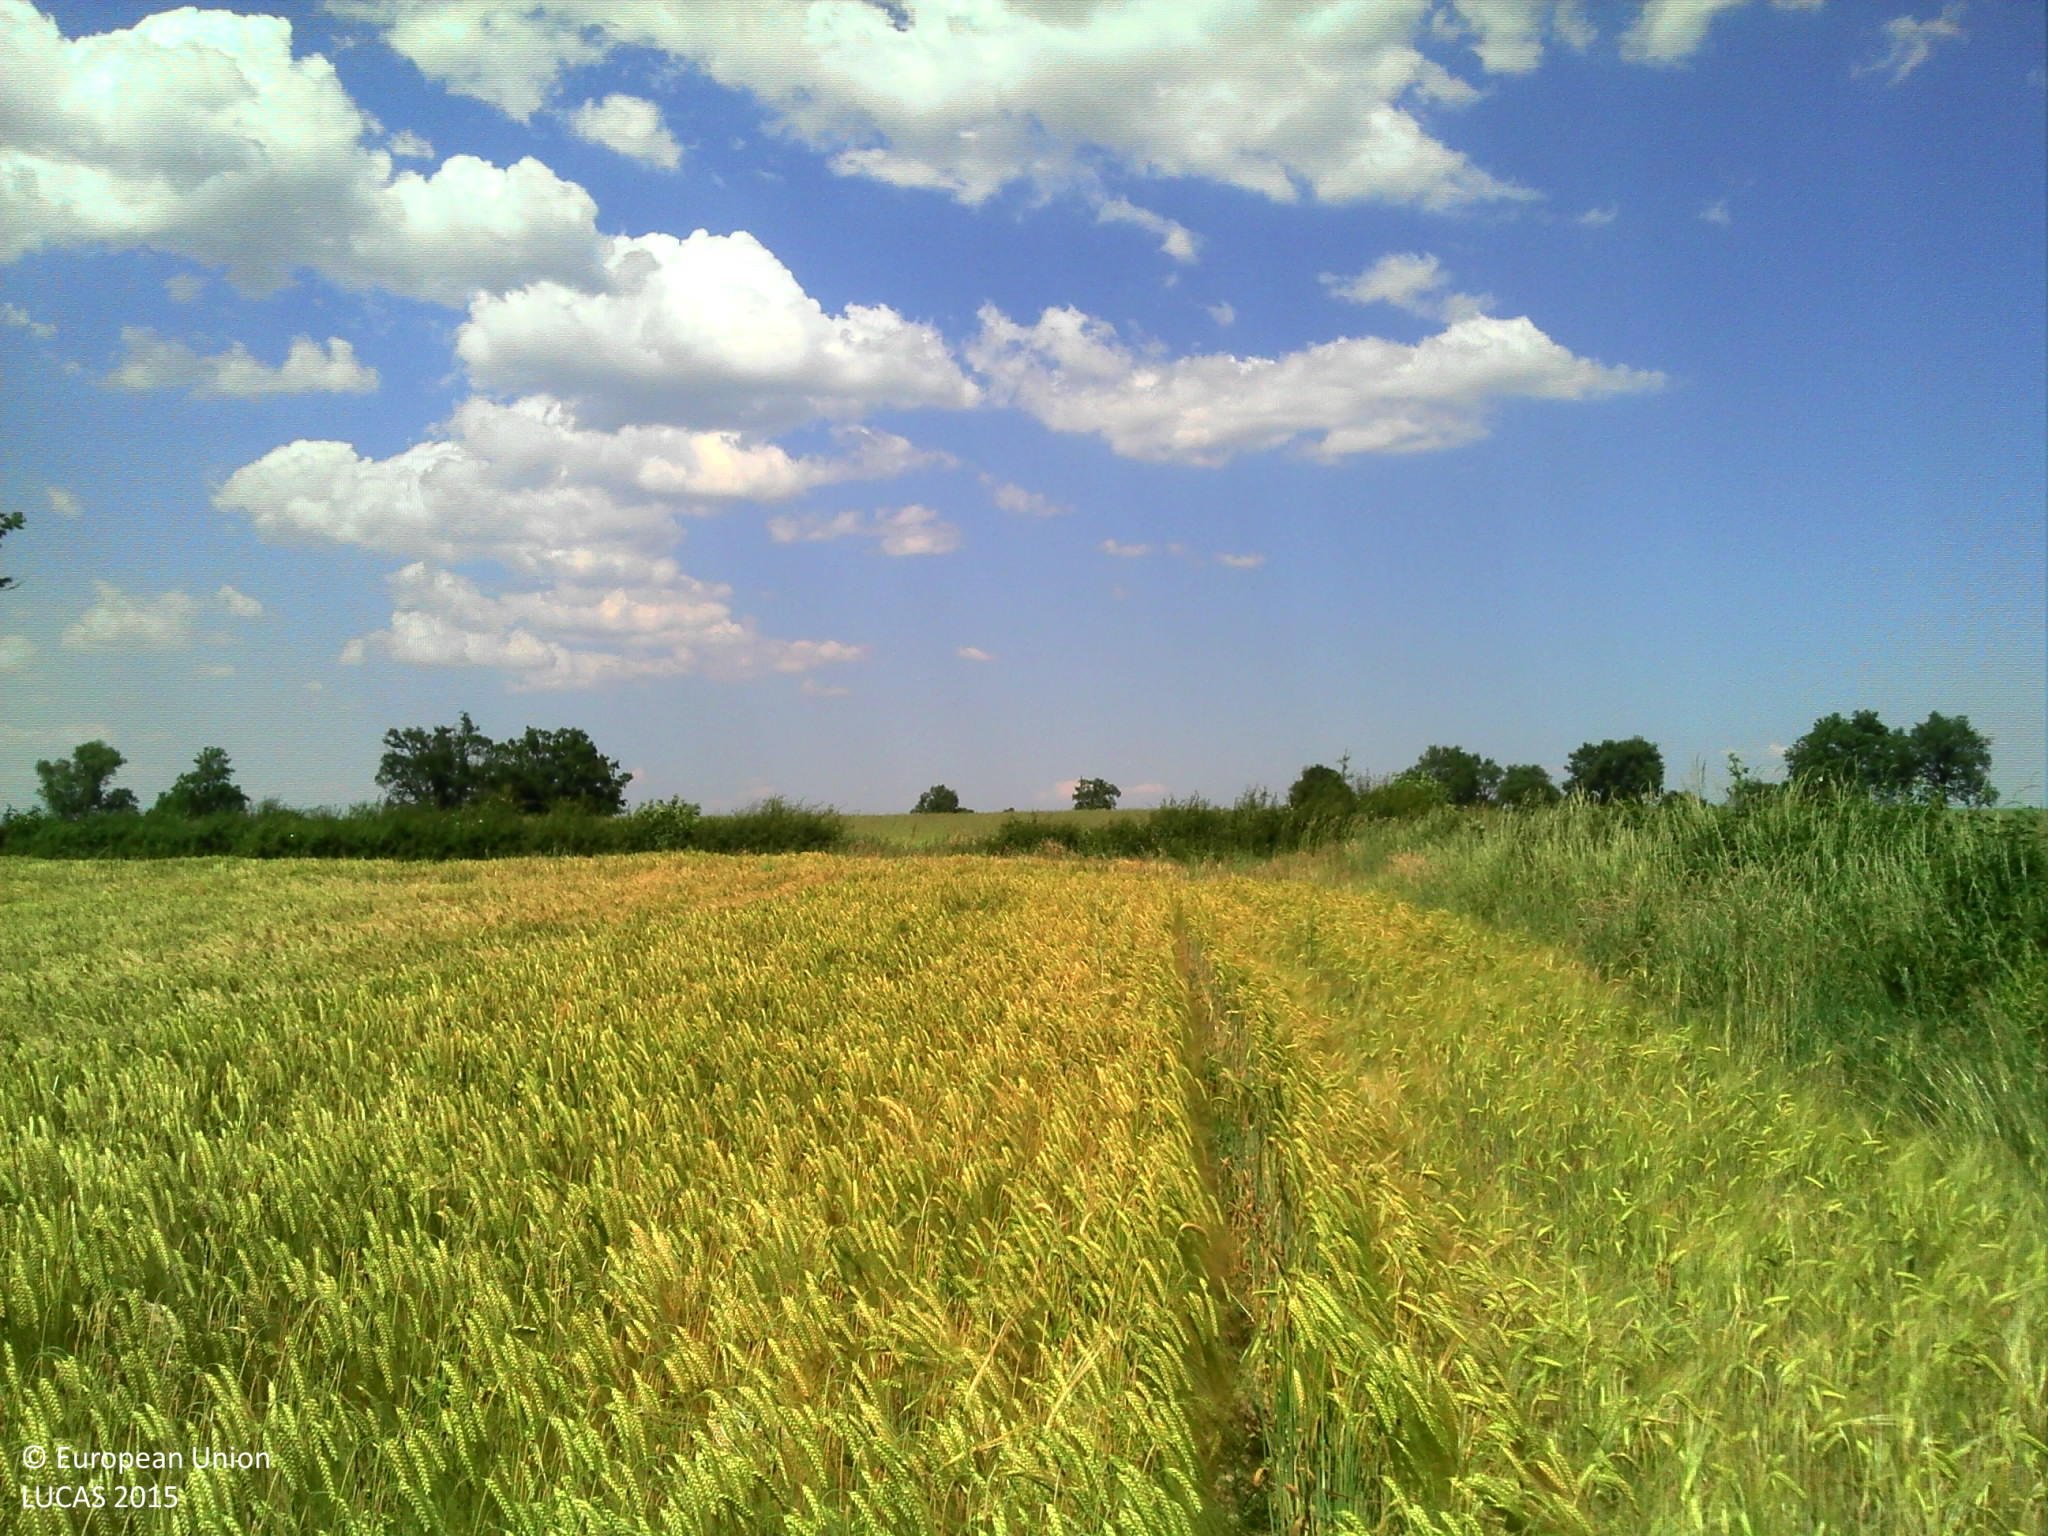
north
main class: Cropland
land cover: Barley
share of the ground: > 75 %
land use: Agriculture (excluding fallow land and kitchen gardens)
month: June
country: FR
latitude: 46.3298
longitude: 2.8657
